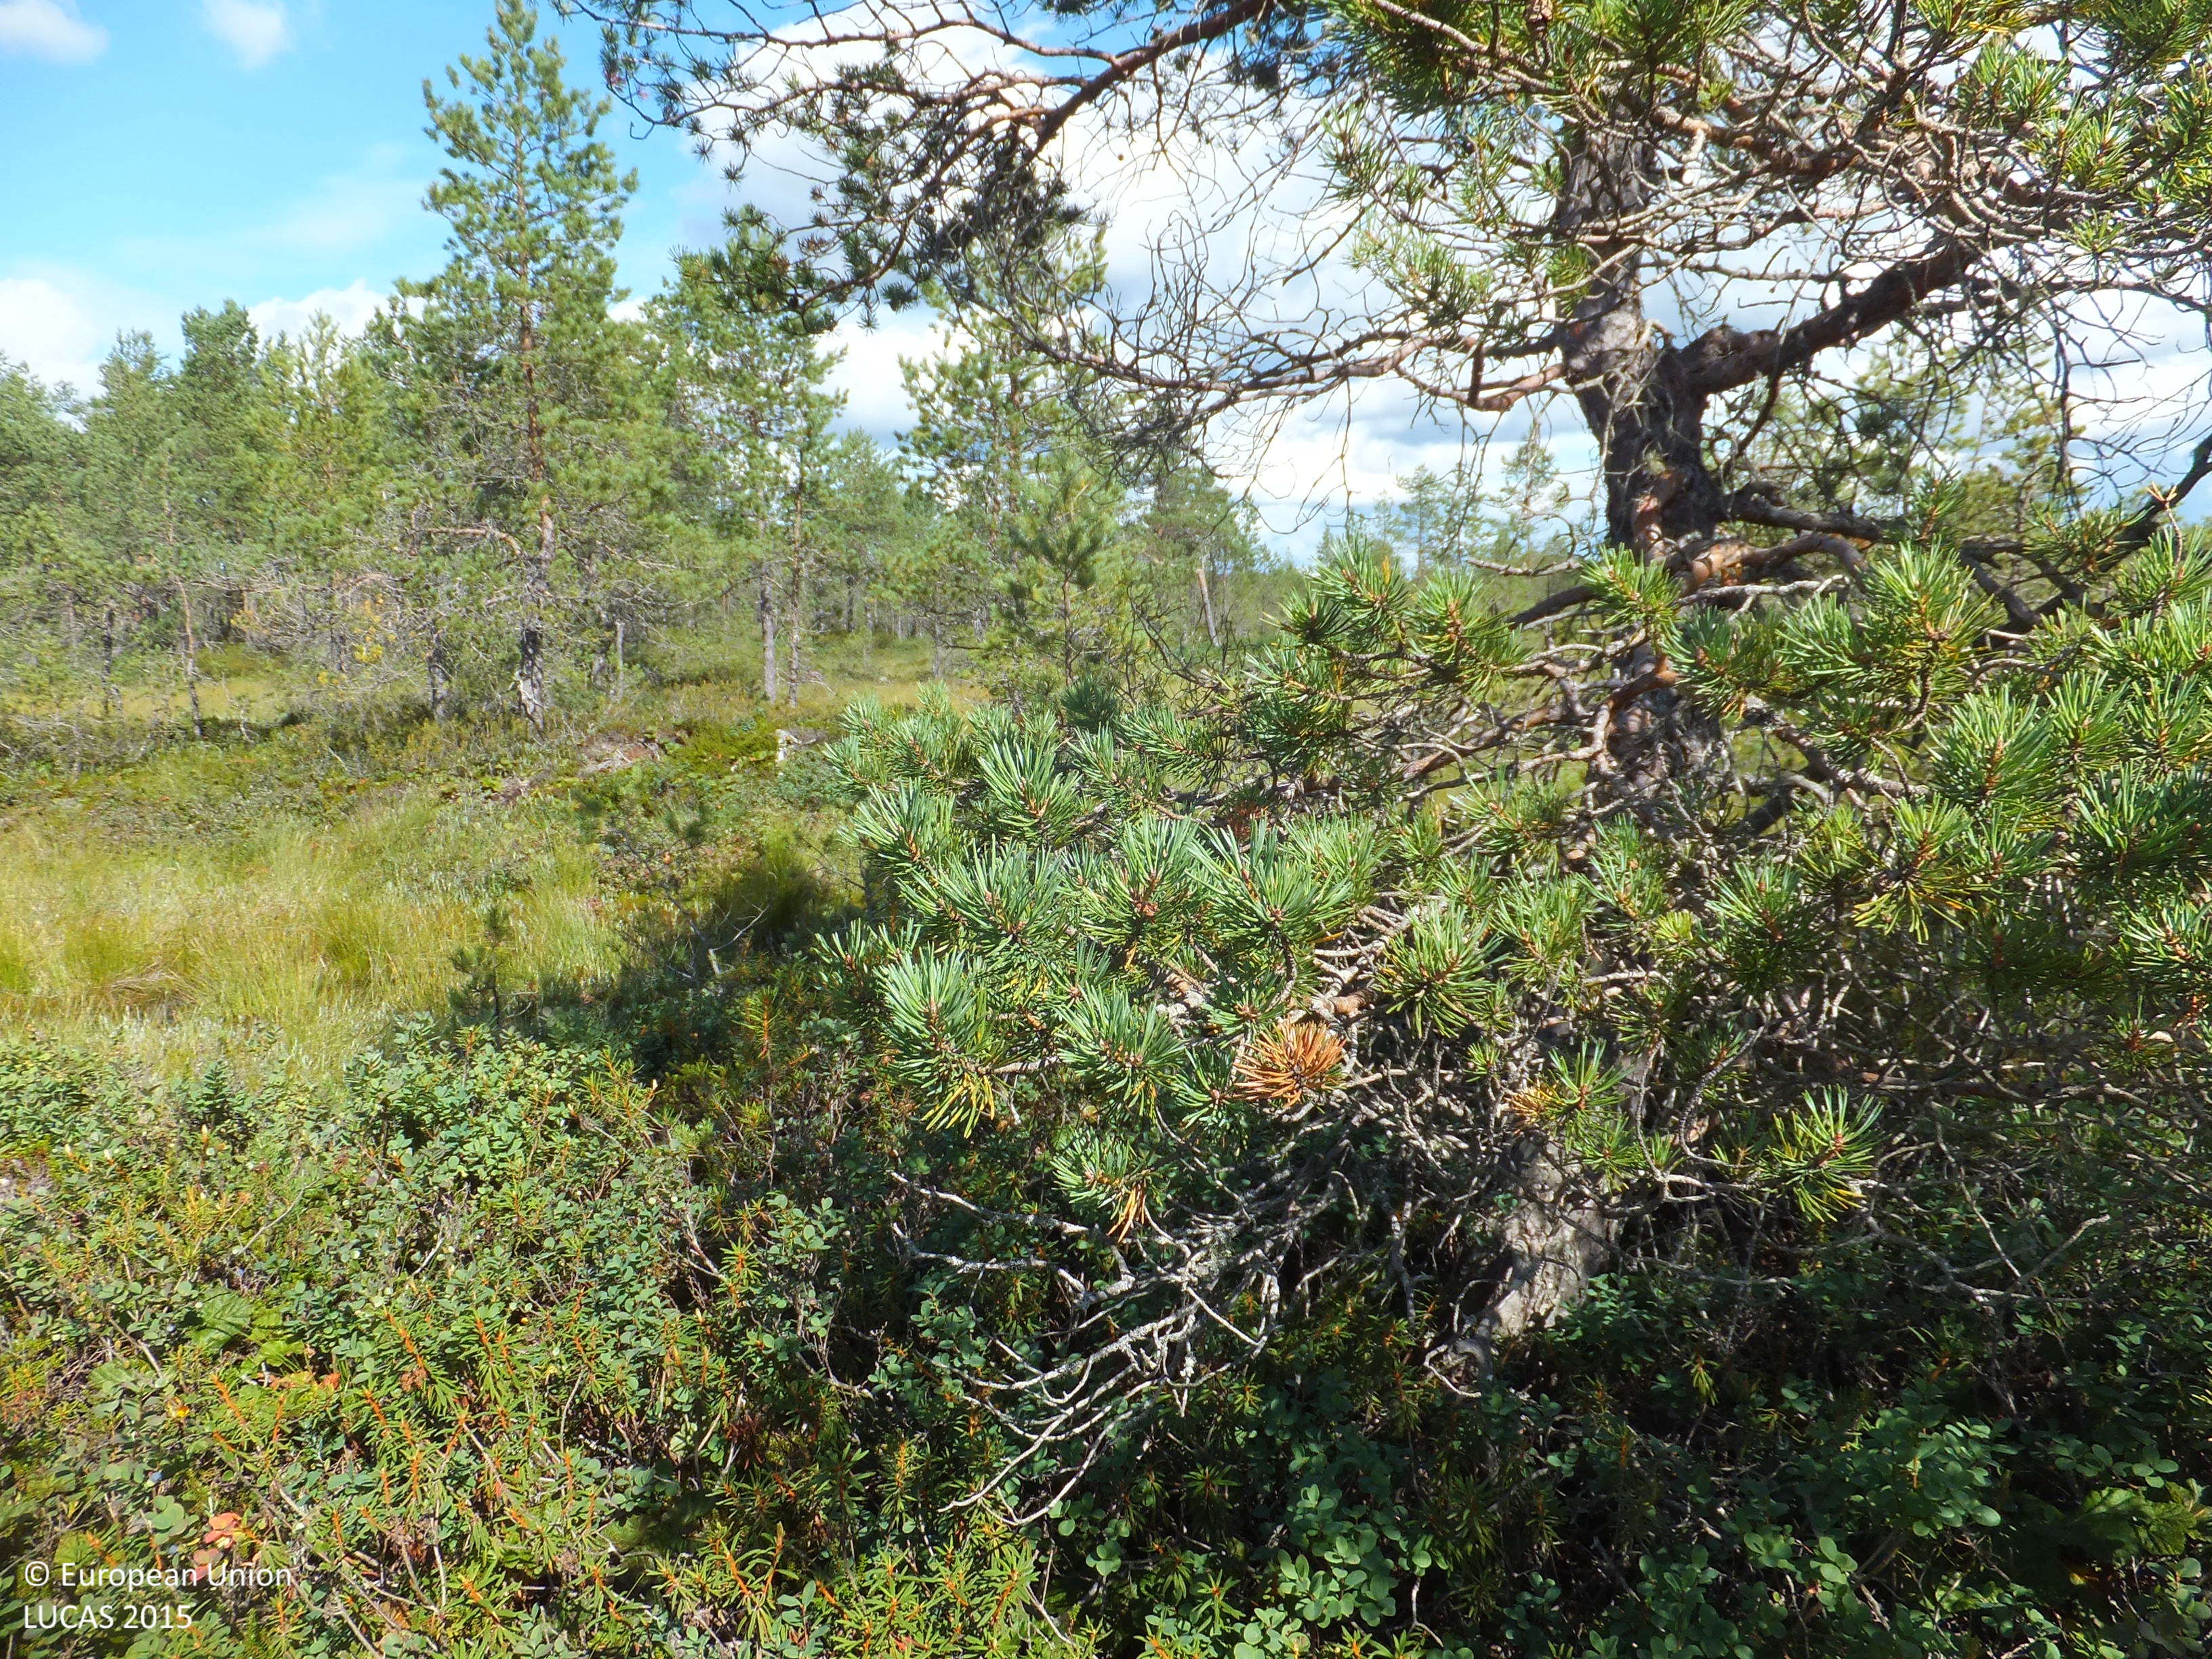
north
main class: Woodland
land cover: Pine dominated coniferous woodland
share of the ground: 10 - 25 %
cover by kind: shrubs 30 %, lichens and mosses 30 %, coniferous forest trees 20 %, herbaceous plants 20 %
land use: Forestry
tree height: < 5 m
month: August
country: FI
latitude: 63.0997
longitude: 22.6729
